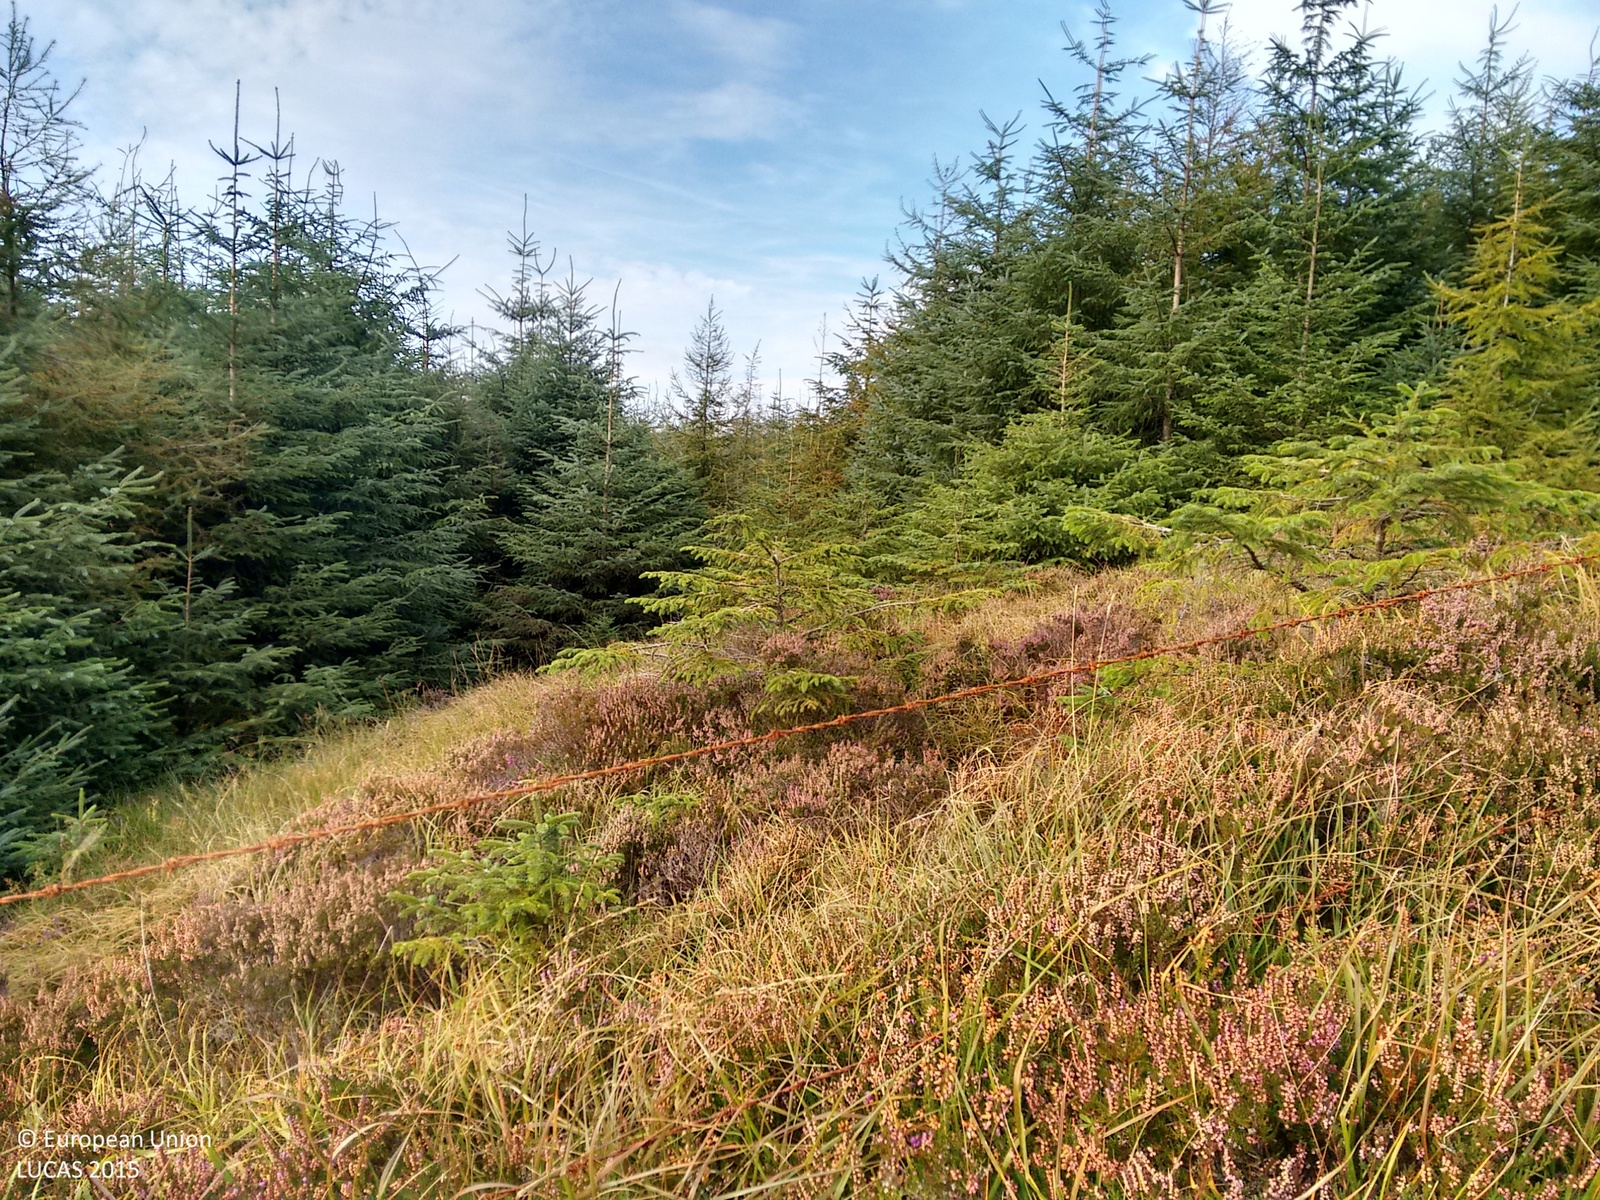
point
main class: Woodland
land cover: Spruce dominated coniferous woodland
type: exotic forest
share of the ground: > 75 %
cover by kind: coniferous forest trees 100 %
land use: Forestry
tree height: > 5 m
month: September
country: IE
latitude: 52.9451
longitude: -9.2568
